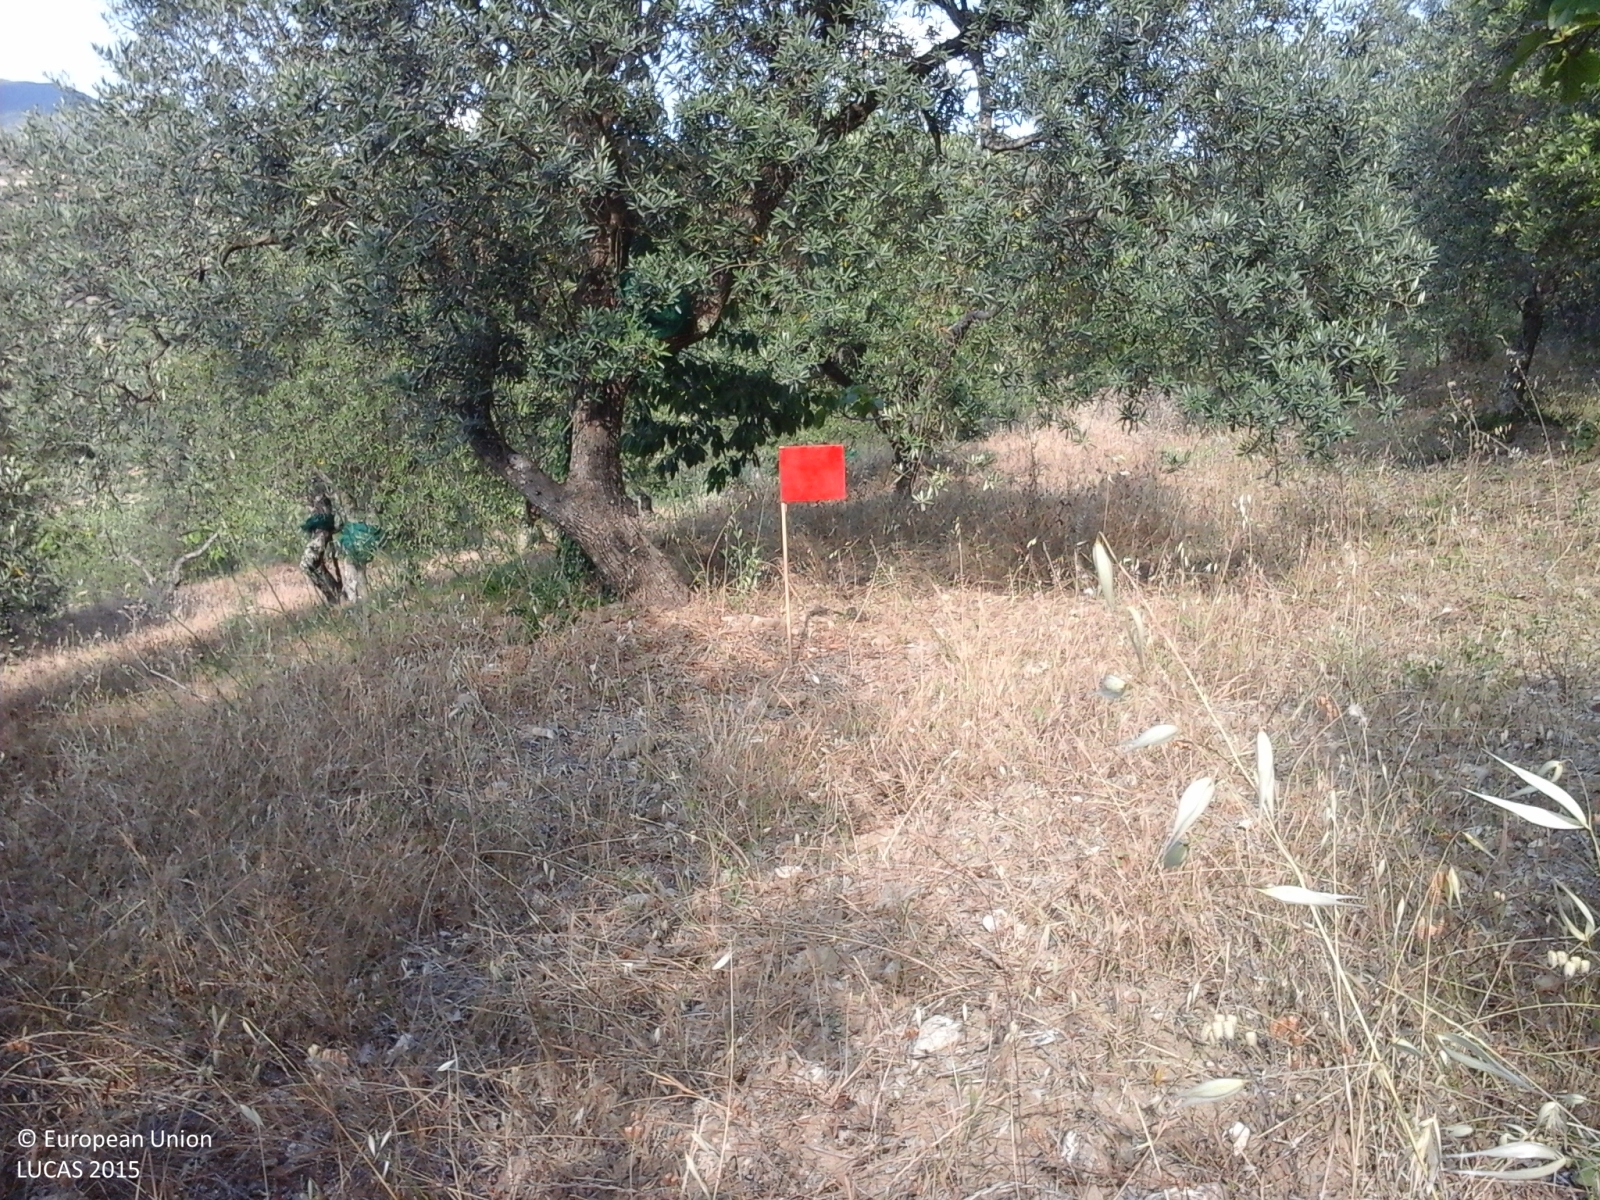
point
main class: Cropland
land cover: Olive groves
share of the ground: 50 - 75 %
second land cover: Other fruit trees and berries
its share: 10 - 25 %
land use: Agriculture (excluding fallow land and kitchen gardens)
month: June
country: IT
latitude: 40.2114
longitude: 15.0180
